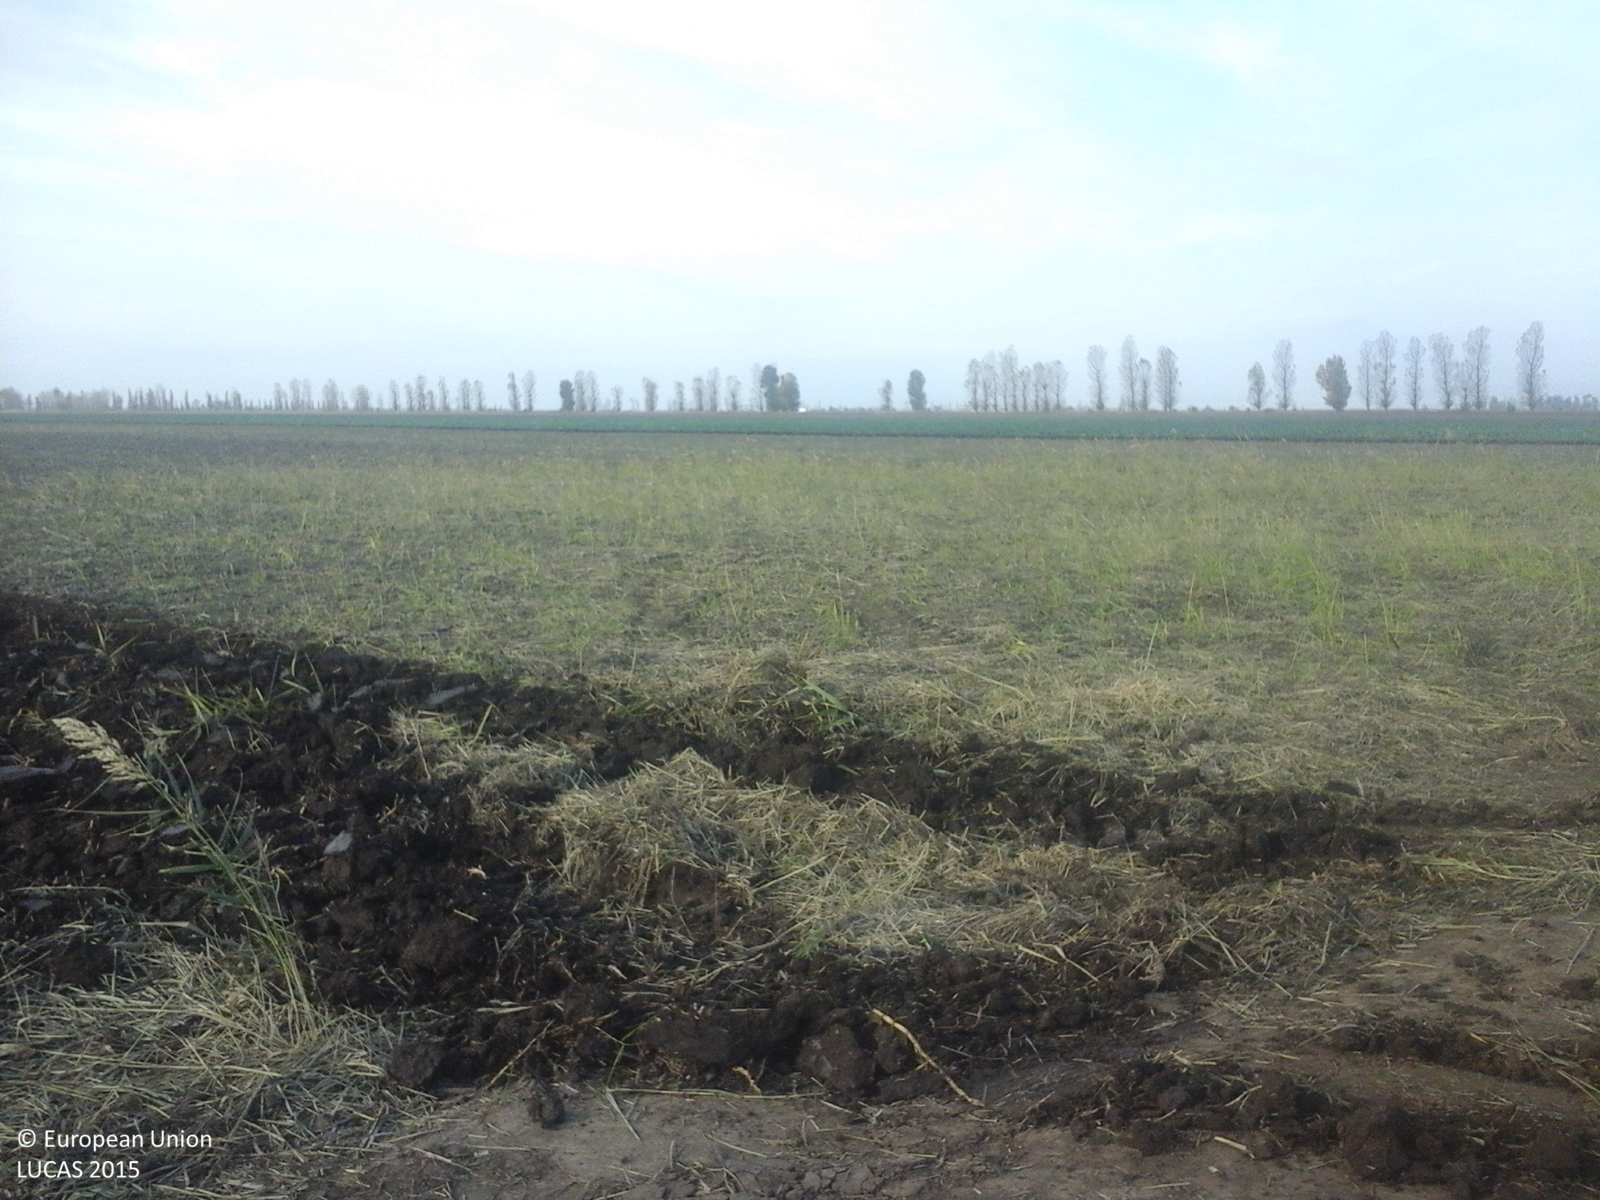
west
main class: Cropland
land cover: Common wheat
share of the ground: > 75 %
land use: Agriculture (excluding fallow land and kitchen gardens)
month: October
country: RO
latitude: 45.2913
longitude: 27.2163
